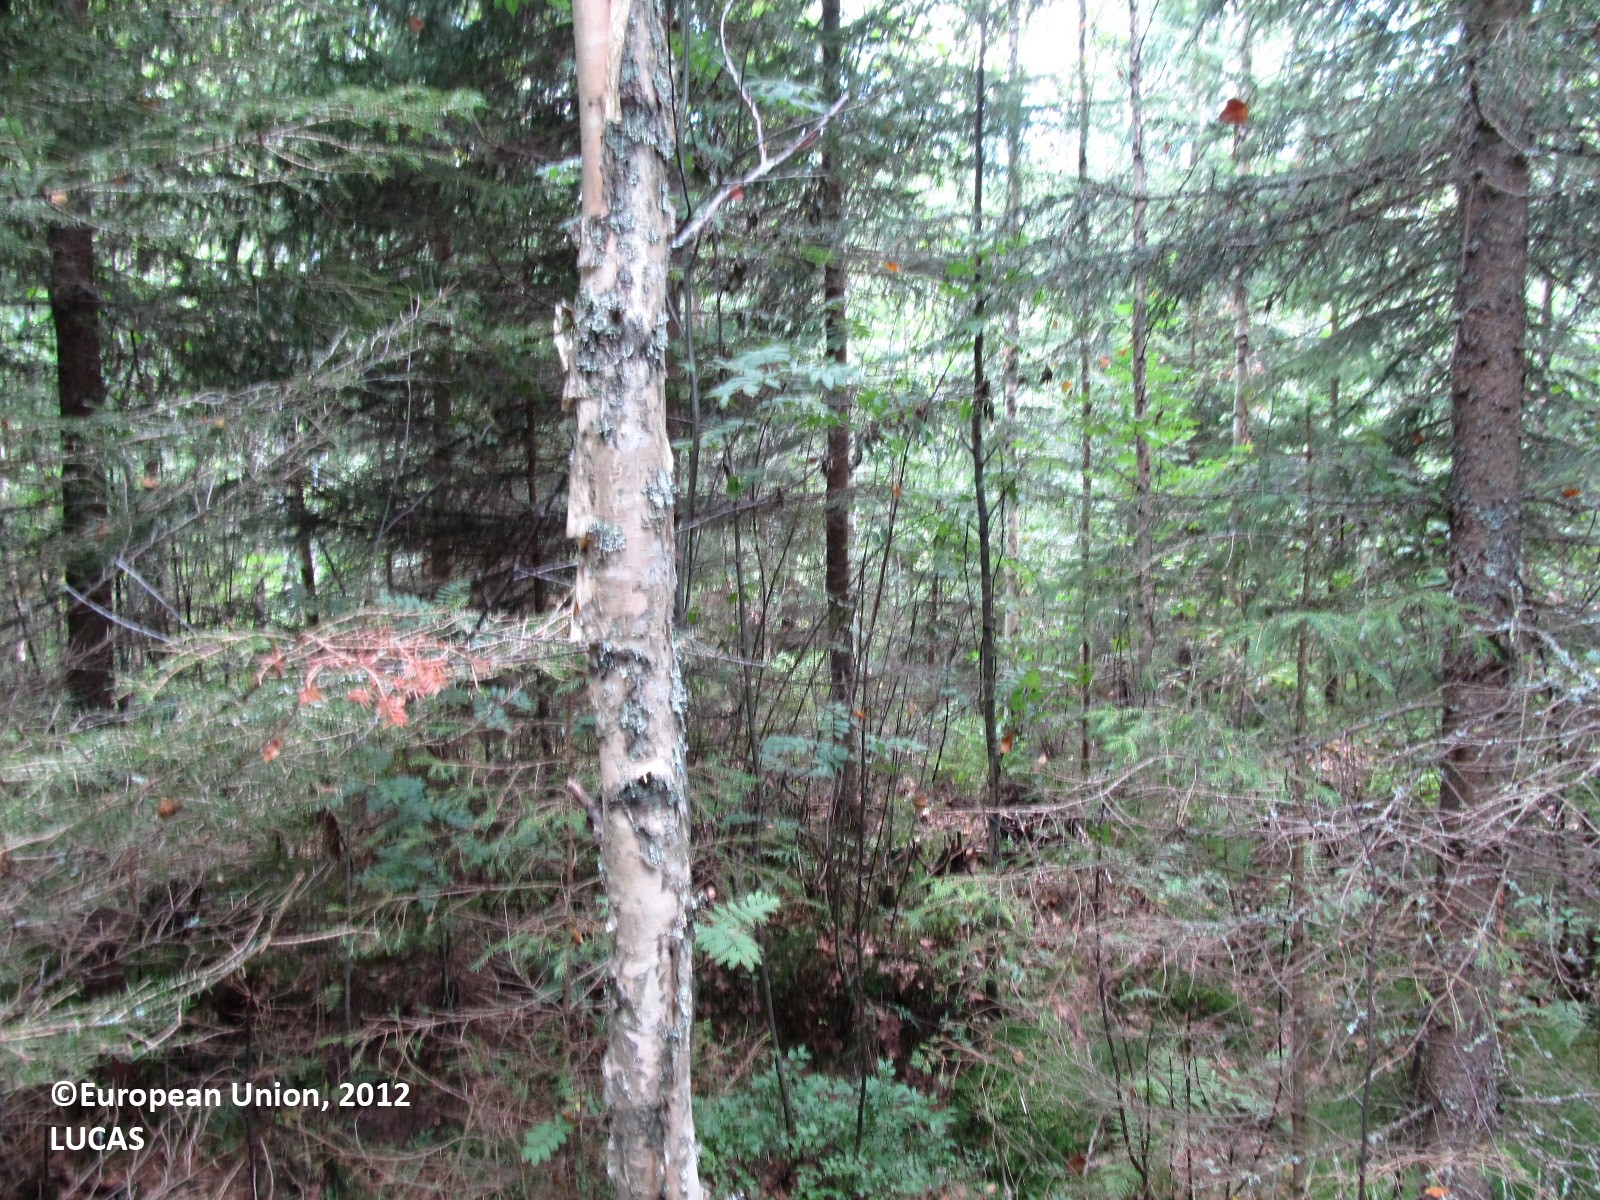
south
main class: Woodland
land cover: Spruce dominated mixed woodland
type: boreal forest
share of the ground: 50 - 75 %
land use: Forestry
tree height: > 5 m
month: August
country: FI
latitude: 61.8186
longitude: 27.7790
